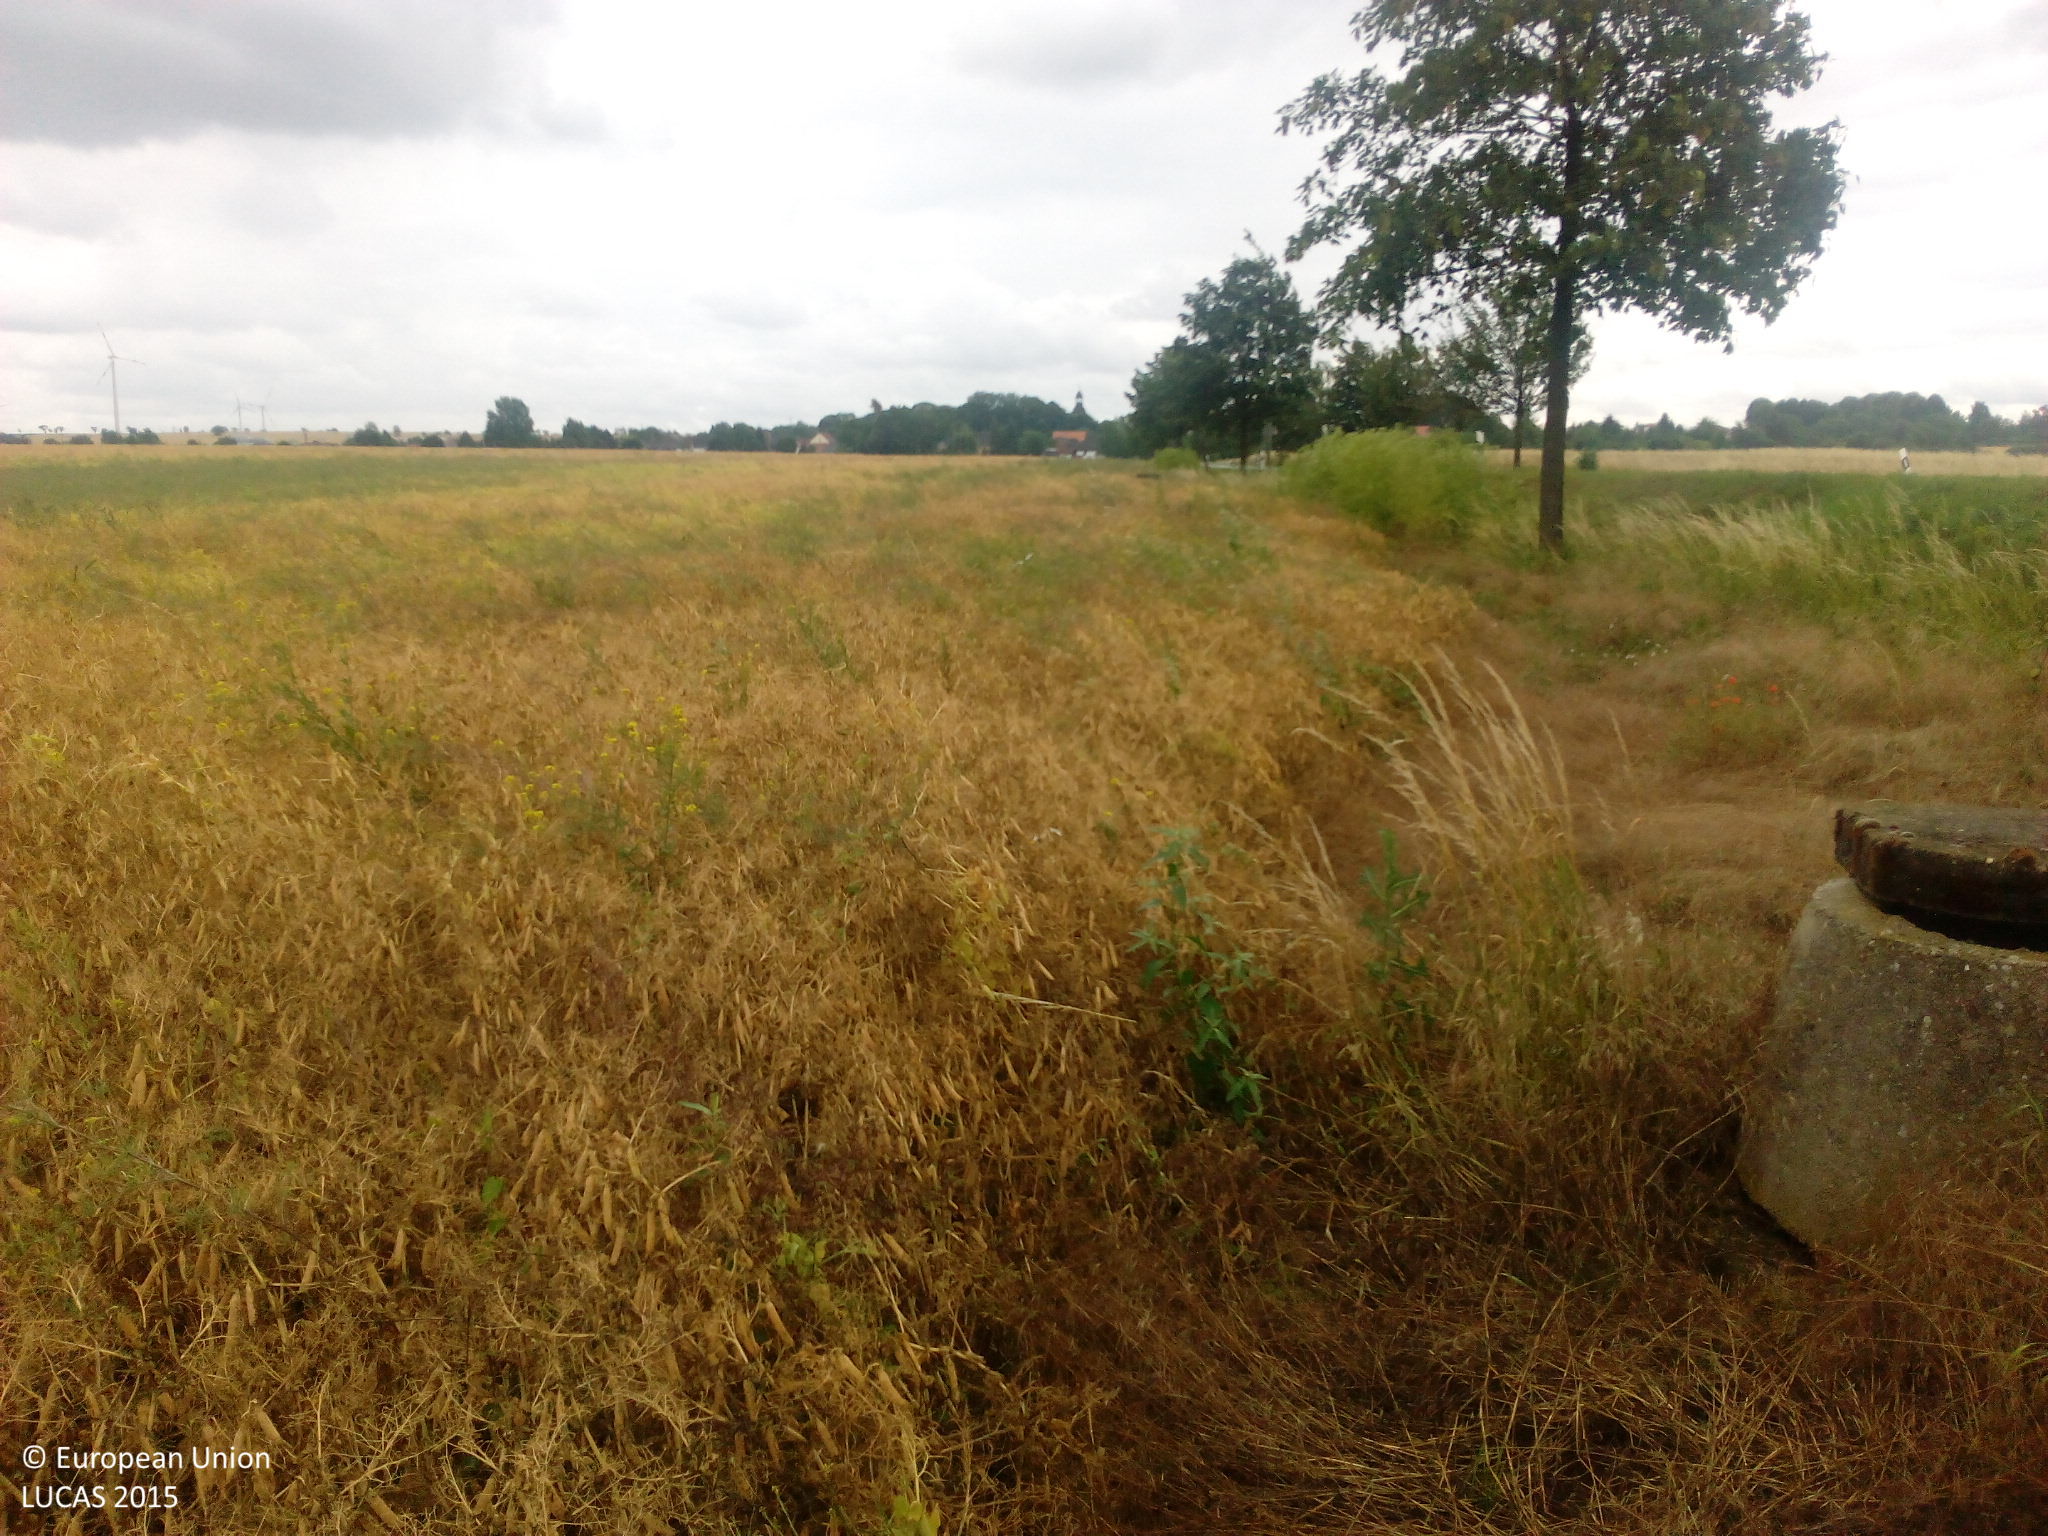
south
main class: Cropland
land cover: Dry pulses
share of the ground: > 75 %
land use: Agriculture (excluding fallow land and kitchen gardens)
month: July
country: DE
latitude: 51.7033
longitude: 11.4611
